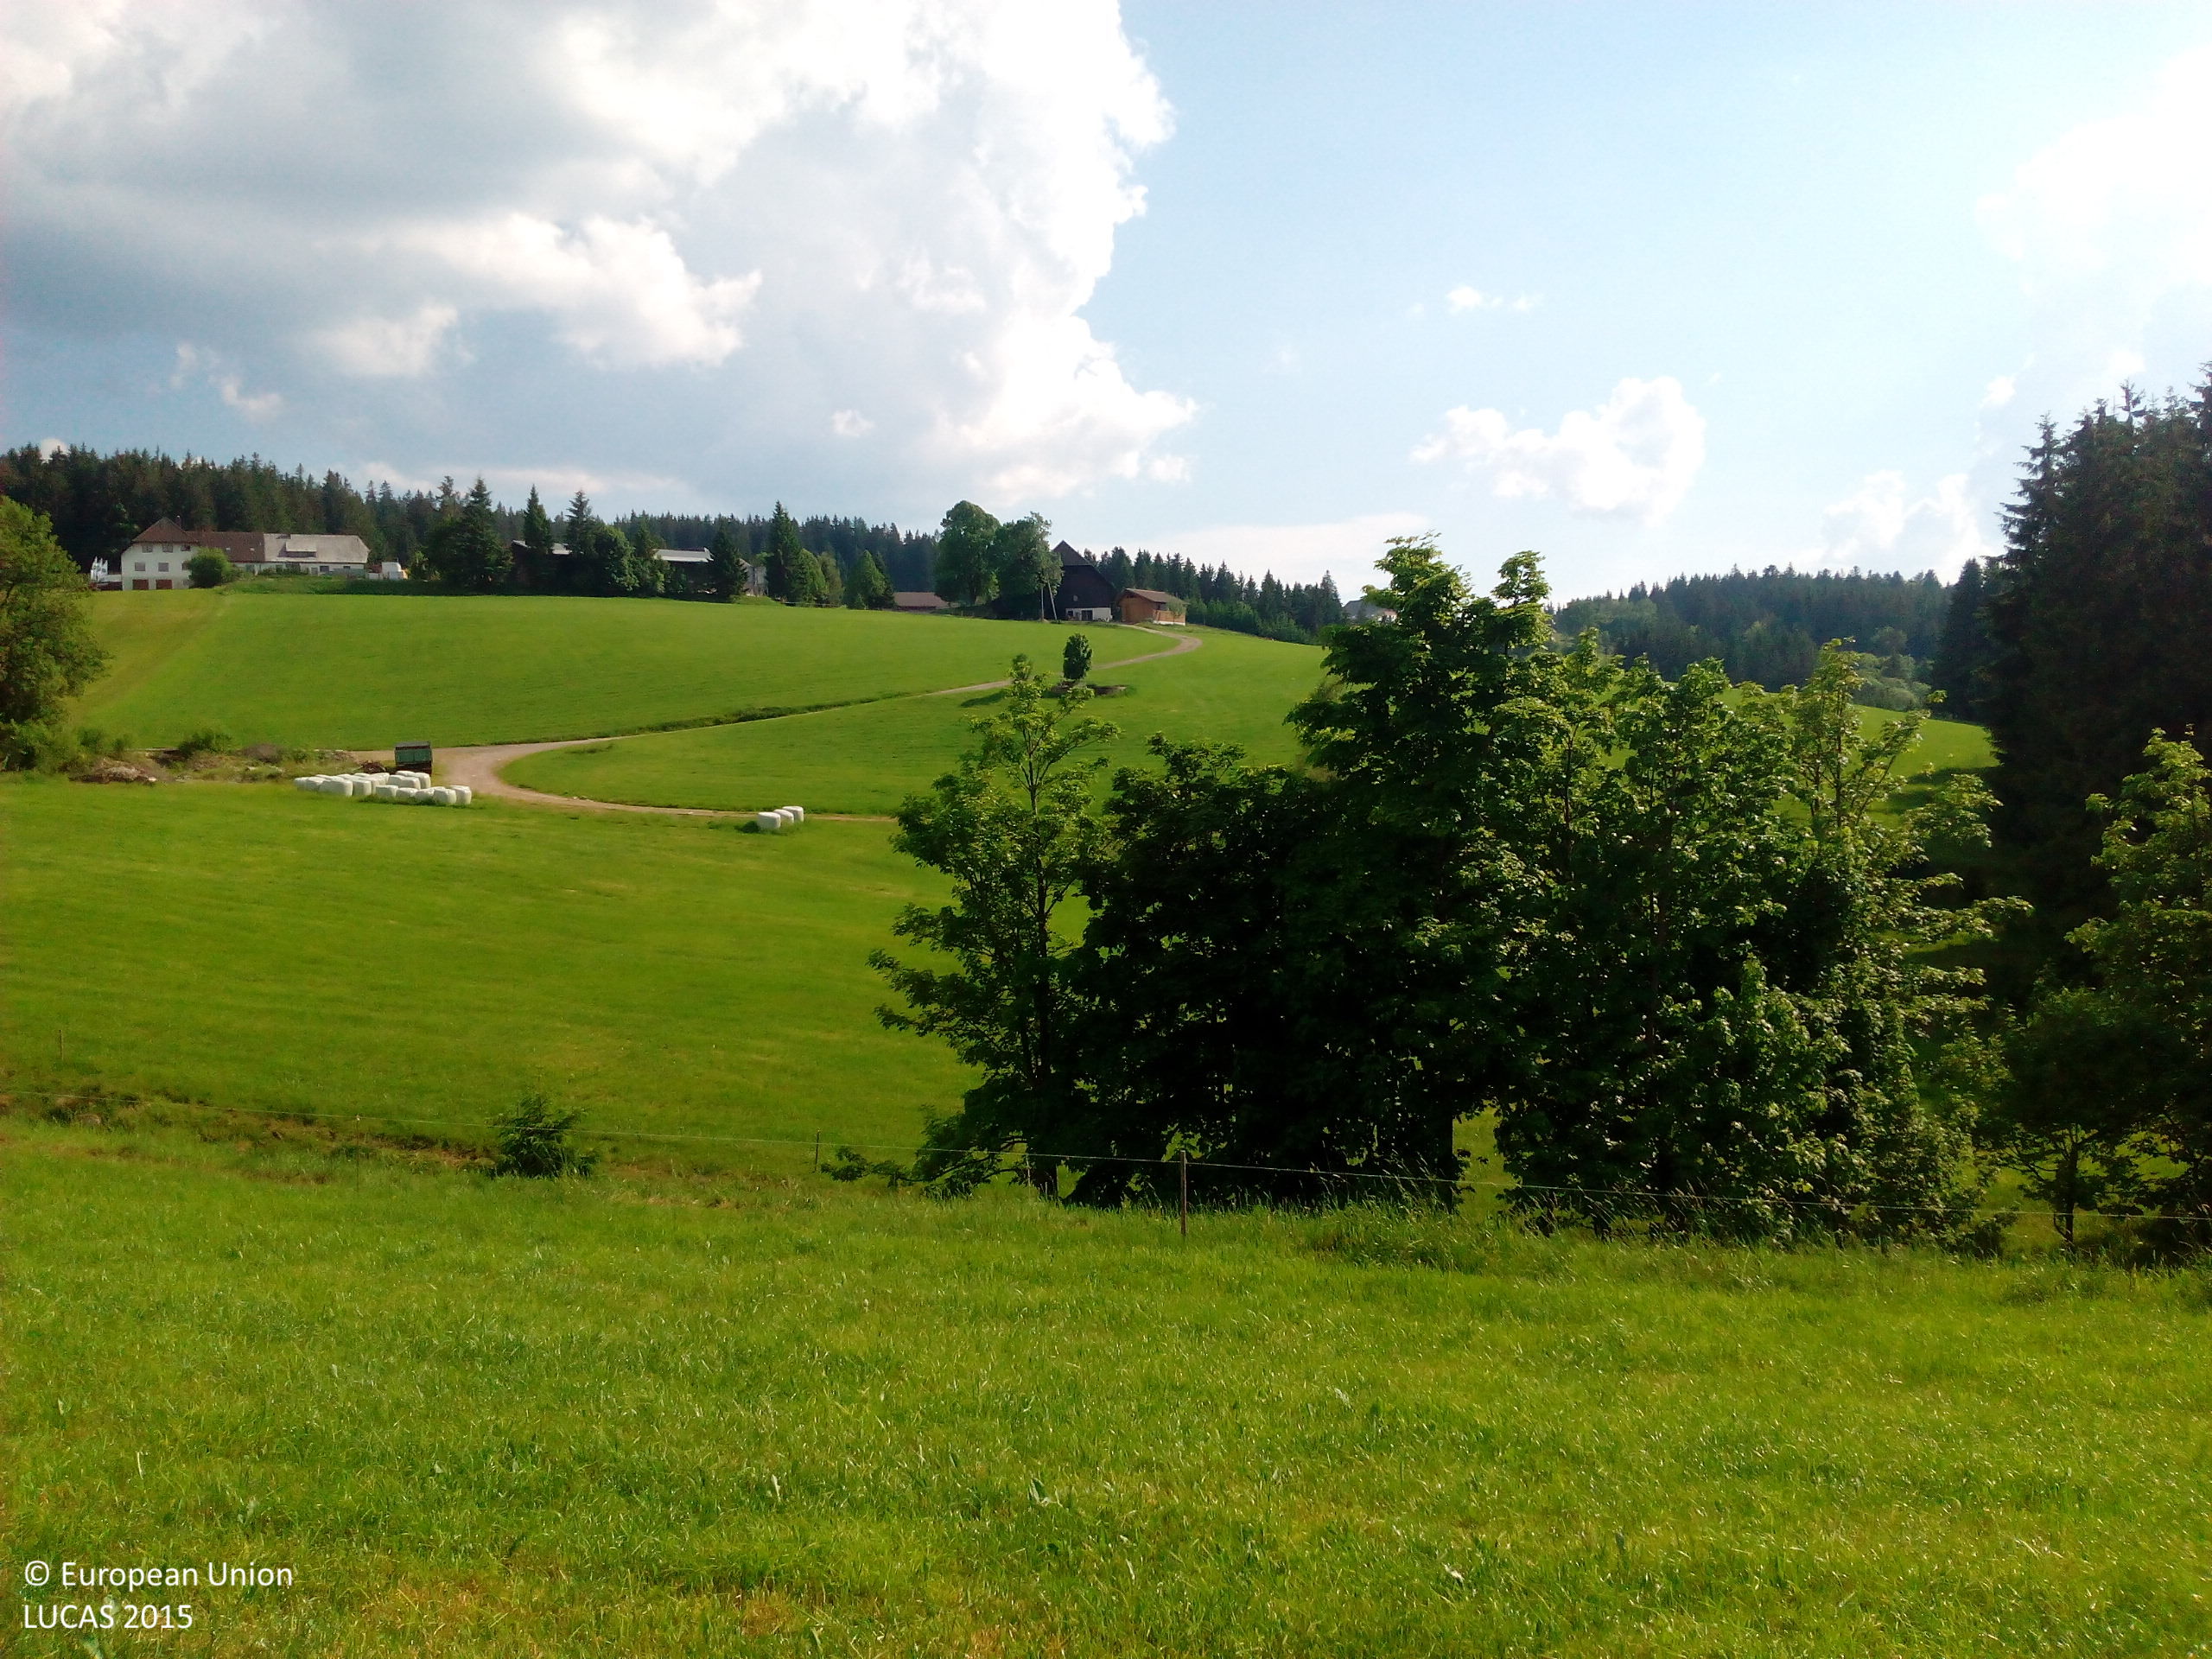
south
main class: Grassland
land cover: Grassland without tree/shrub cover
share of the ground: > 75 %
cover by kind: herbaceous plants 100 %
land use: Agriculture (excluding fallow land and kitchen gardens)
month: June
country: DE
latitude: 47.9734
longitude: 8.1123
